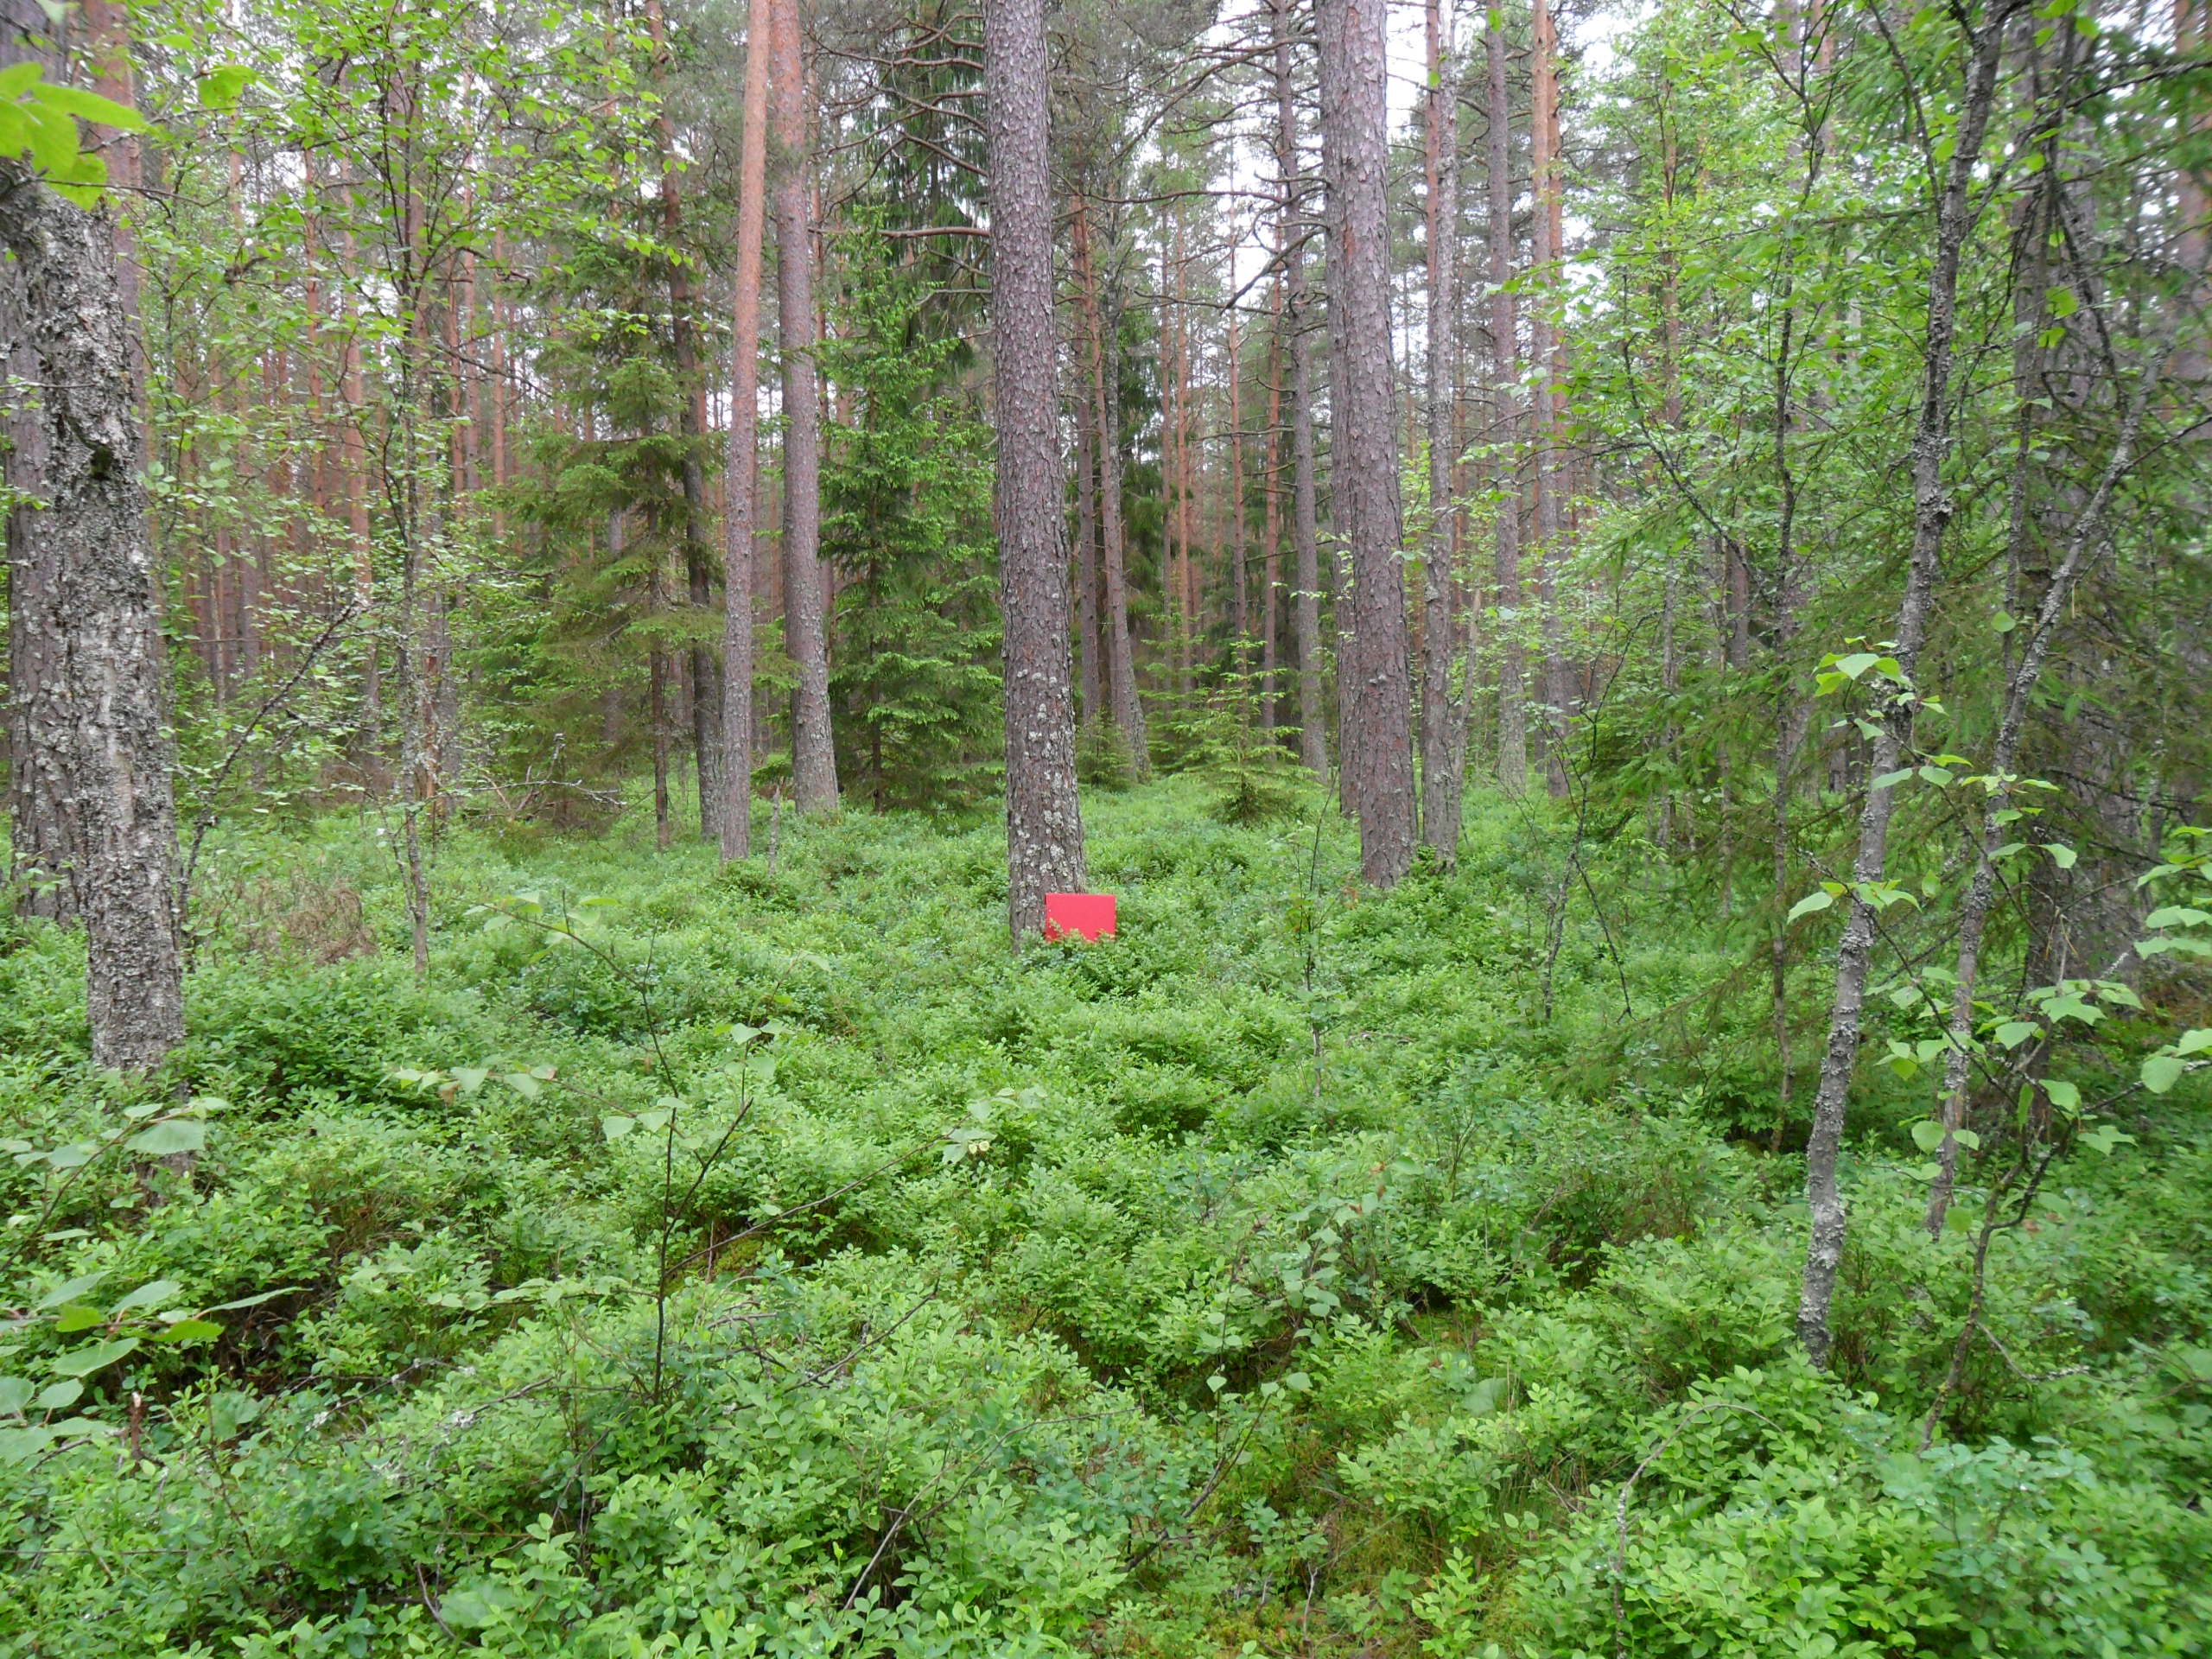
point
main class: Woodland
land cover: Other mixed woodland
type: hemiboreal forest and nemoral coniferous forest and mixed broadleaved-coniferous forest
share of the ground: 50 - 75 %
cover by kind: coniferous forest trees 40 %, broadleaved forest trees 30 %, herbaceous plants 20 %, shrubs 10 %
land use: Forestry
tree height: > 5 m
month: June
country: LV
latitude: 57.2576
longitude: 22.0322
